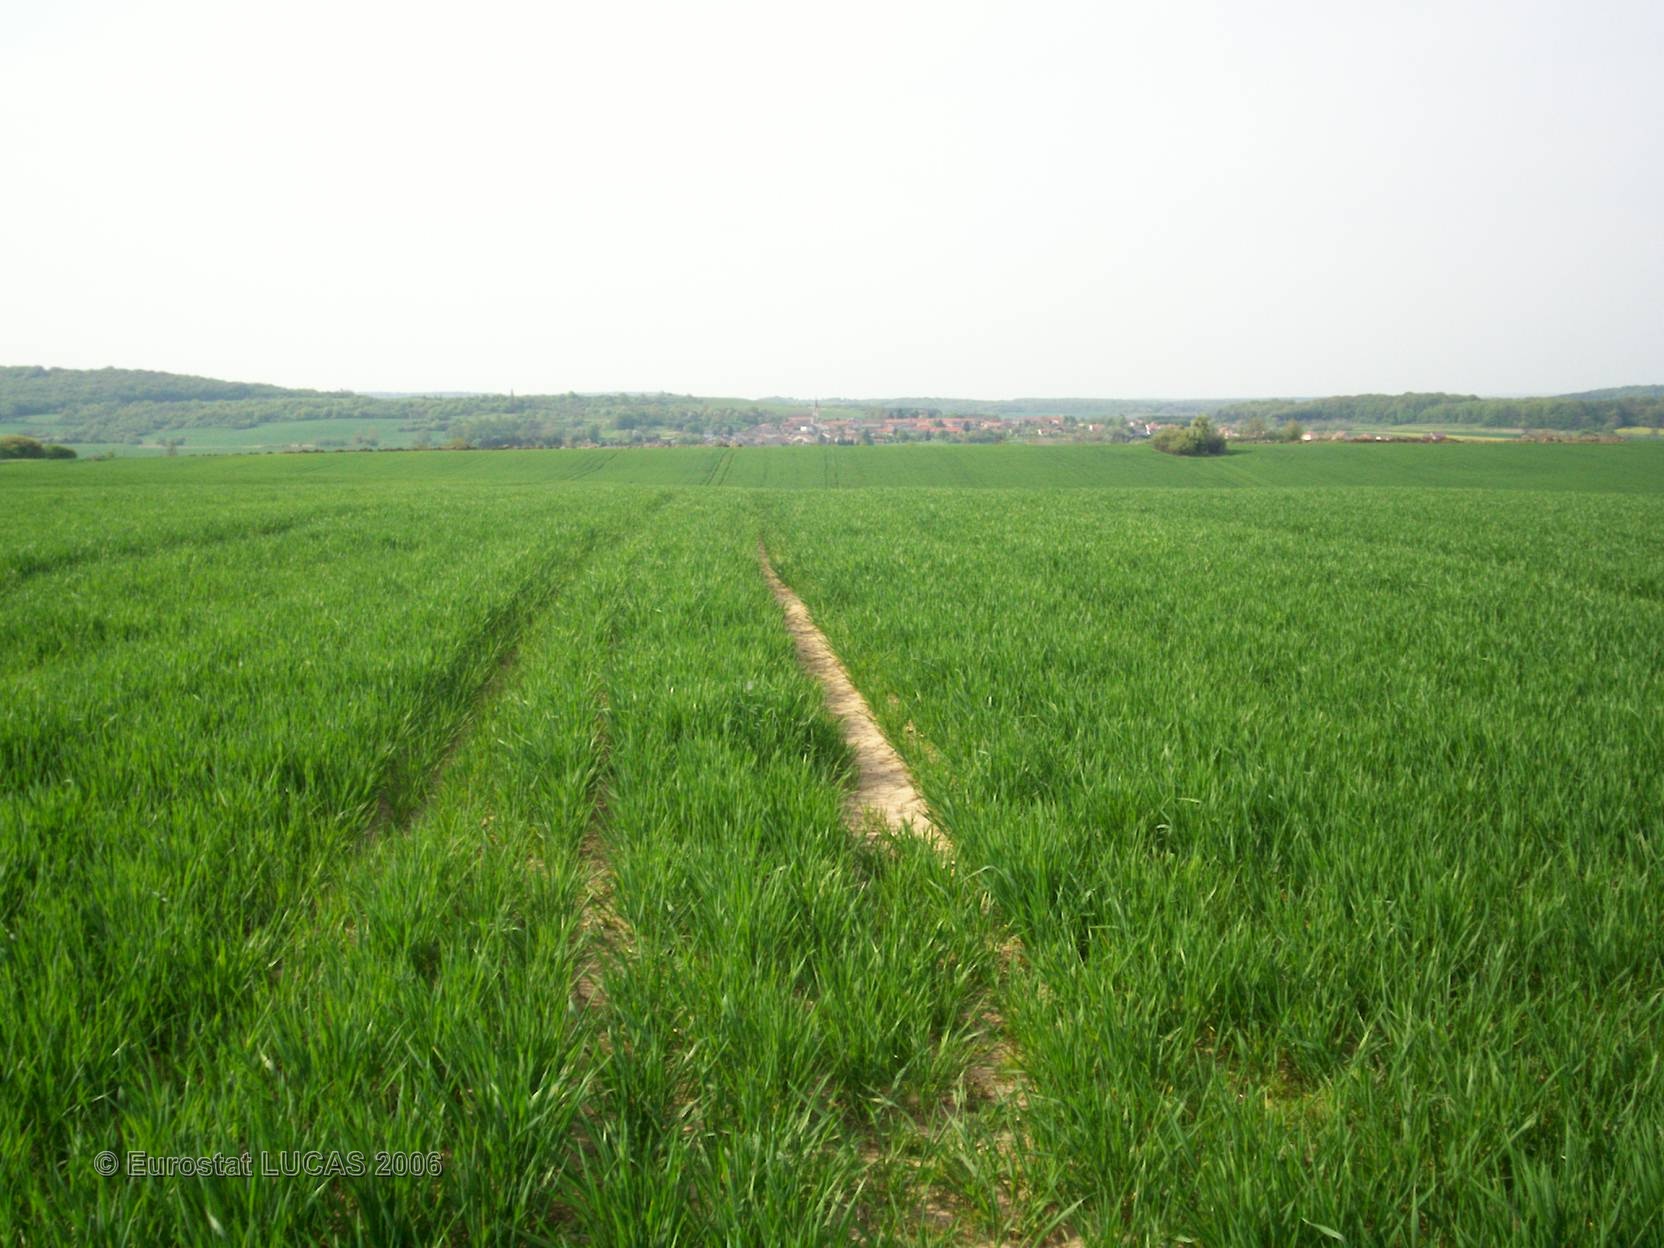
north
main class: Cropland
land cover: Common wheat
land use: Agriculture (excluding fallow land and kitchen gardens)
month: May
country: FR
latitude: 49.2467
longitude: 6.4420
